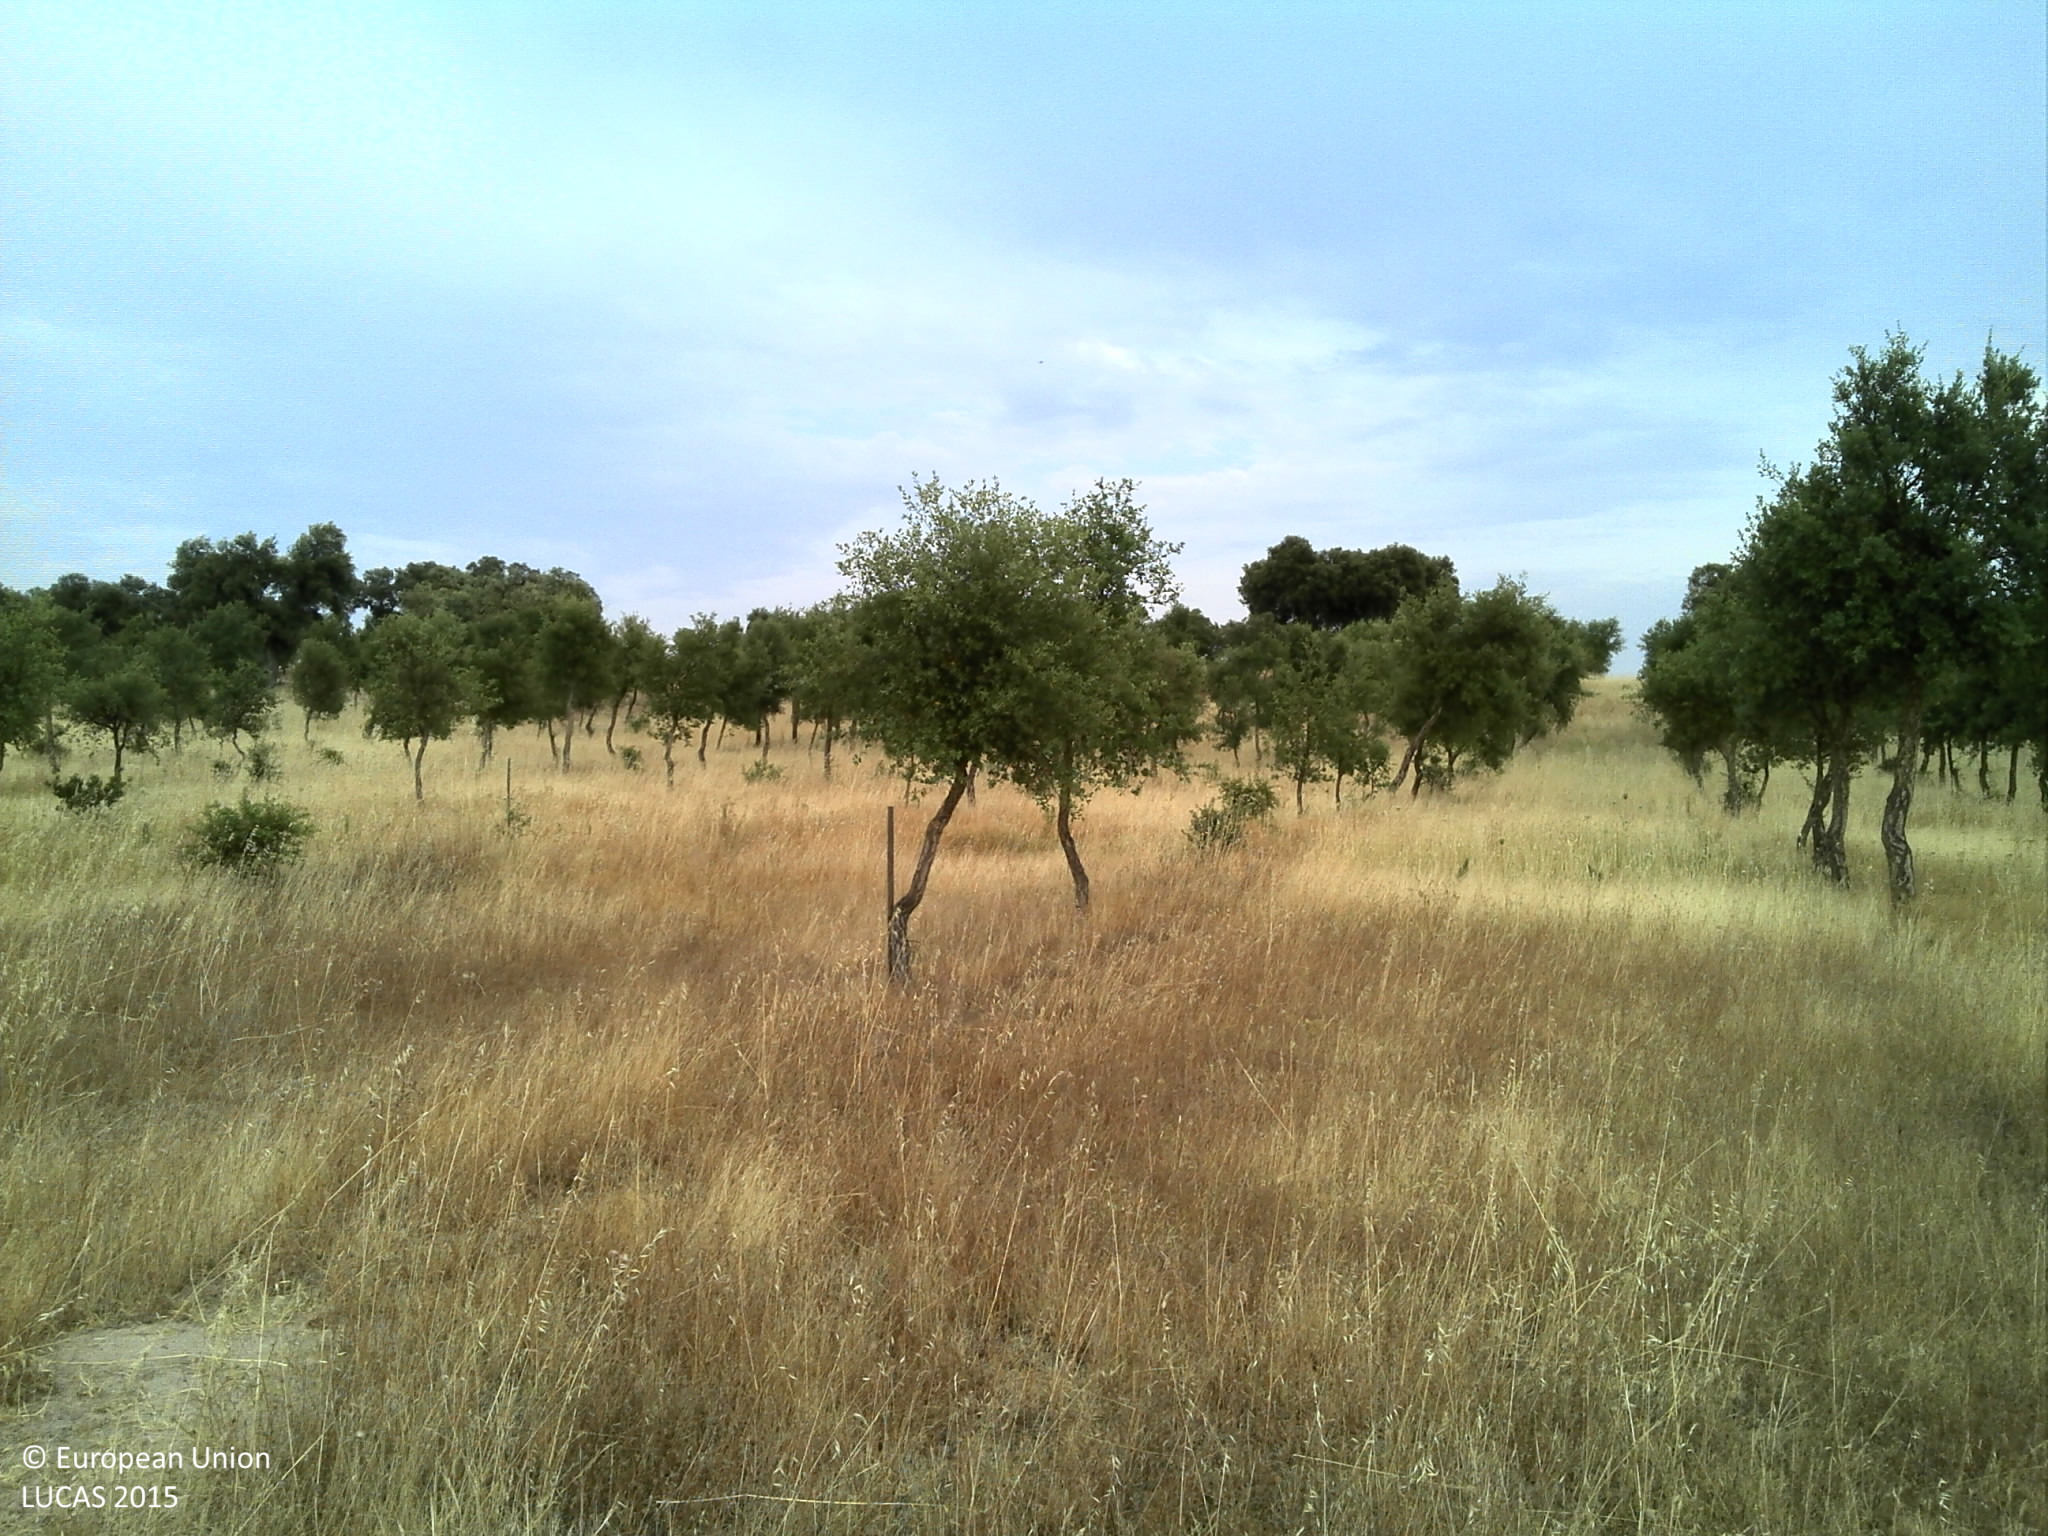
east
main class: Woodland
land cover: Broadleaved woodland
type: broadleaved evergreen forest
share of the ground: 25 - 50 %
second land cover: Grassland without tree/shrub cover
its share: 50 - 75 %
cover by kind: herbaceous plants 60 %, broadleaved forest trees 30 %, unconsolidated bare surface 10 %
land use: Forestry
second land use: Agriculture (excluding fallow land and kitchen gardens)
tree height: < 5 m
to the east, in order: Broadleaved woodland; Grassland without tree/shrub cover; Broadleaved woodland
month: June
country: PT
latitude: 38.6318
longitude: -7.7622
